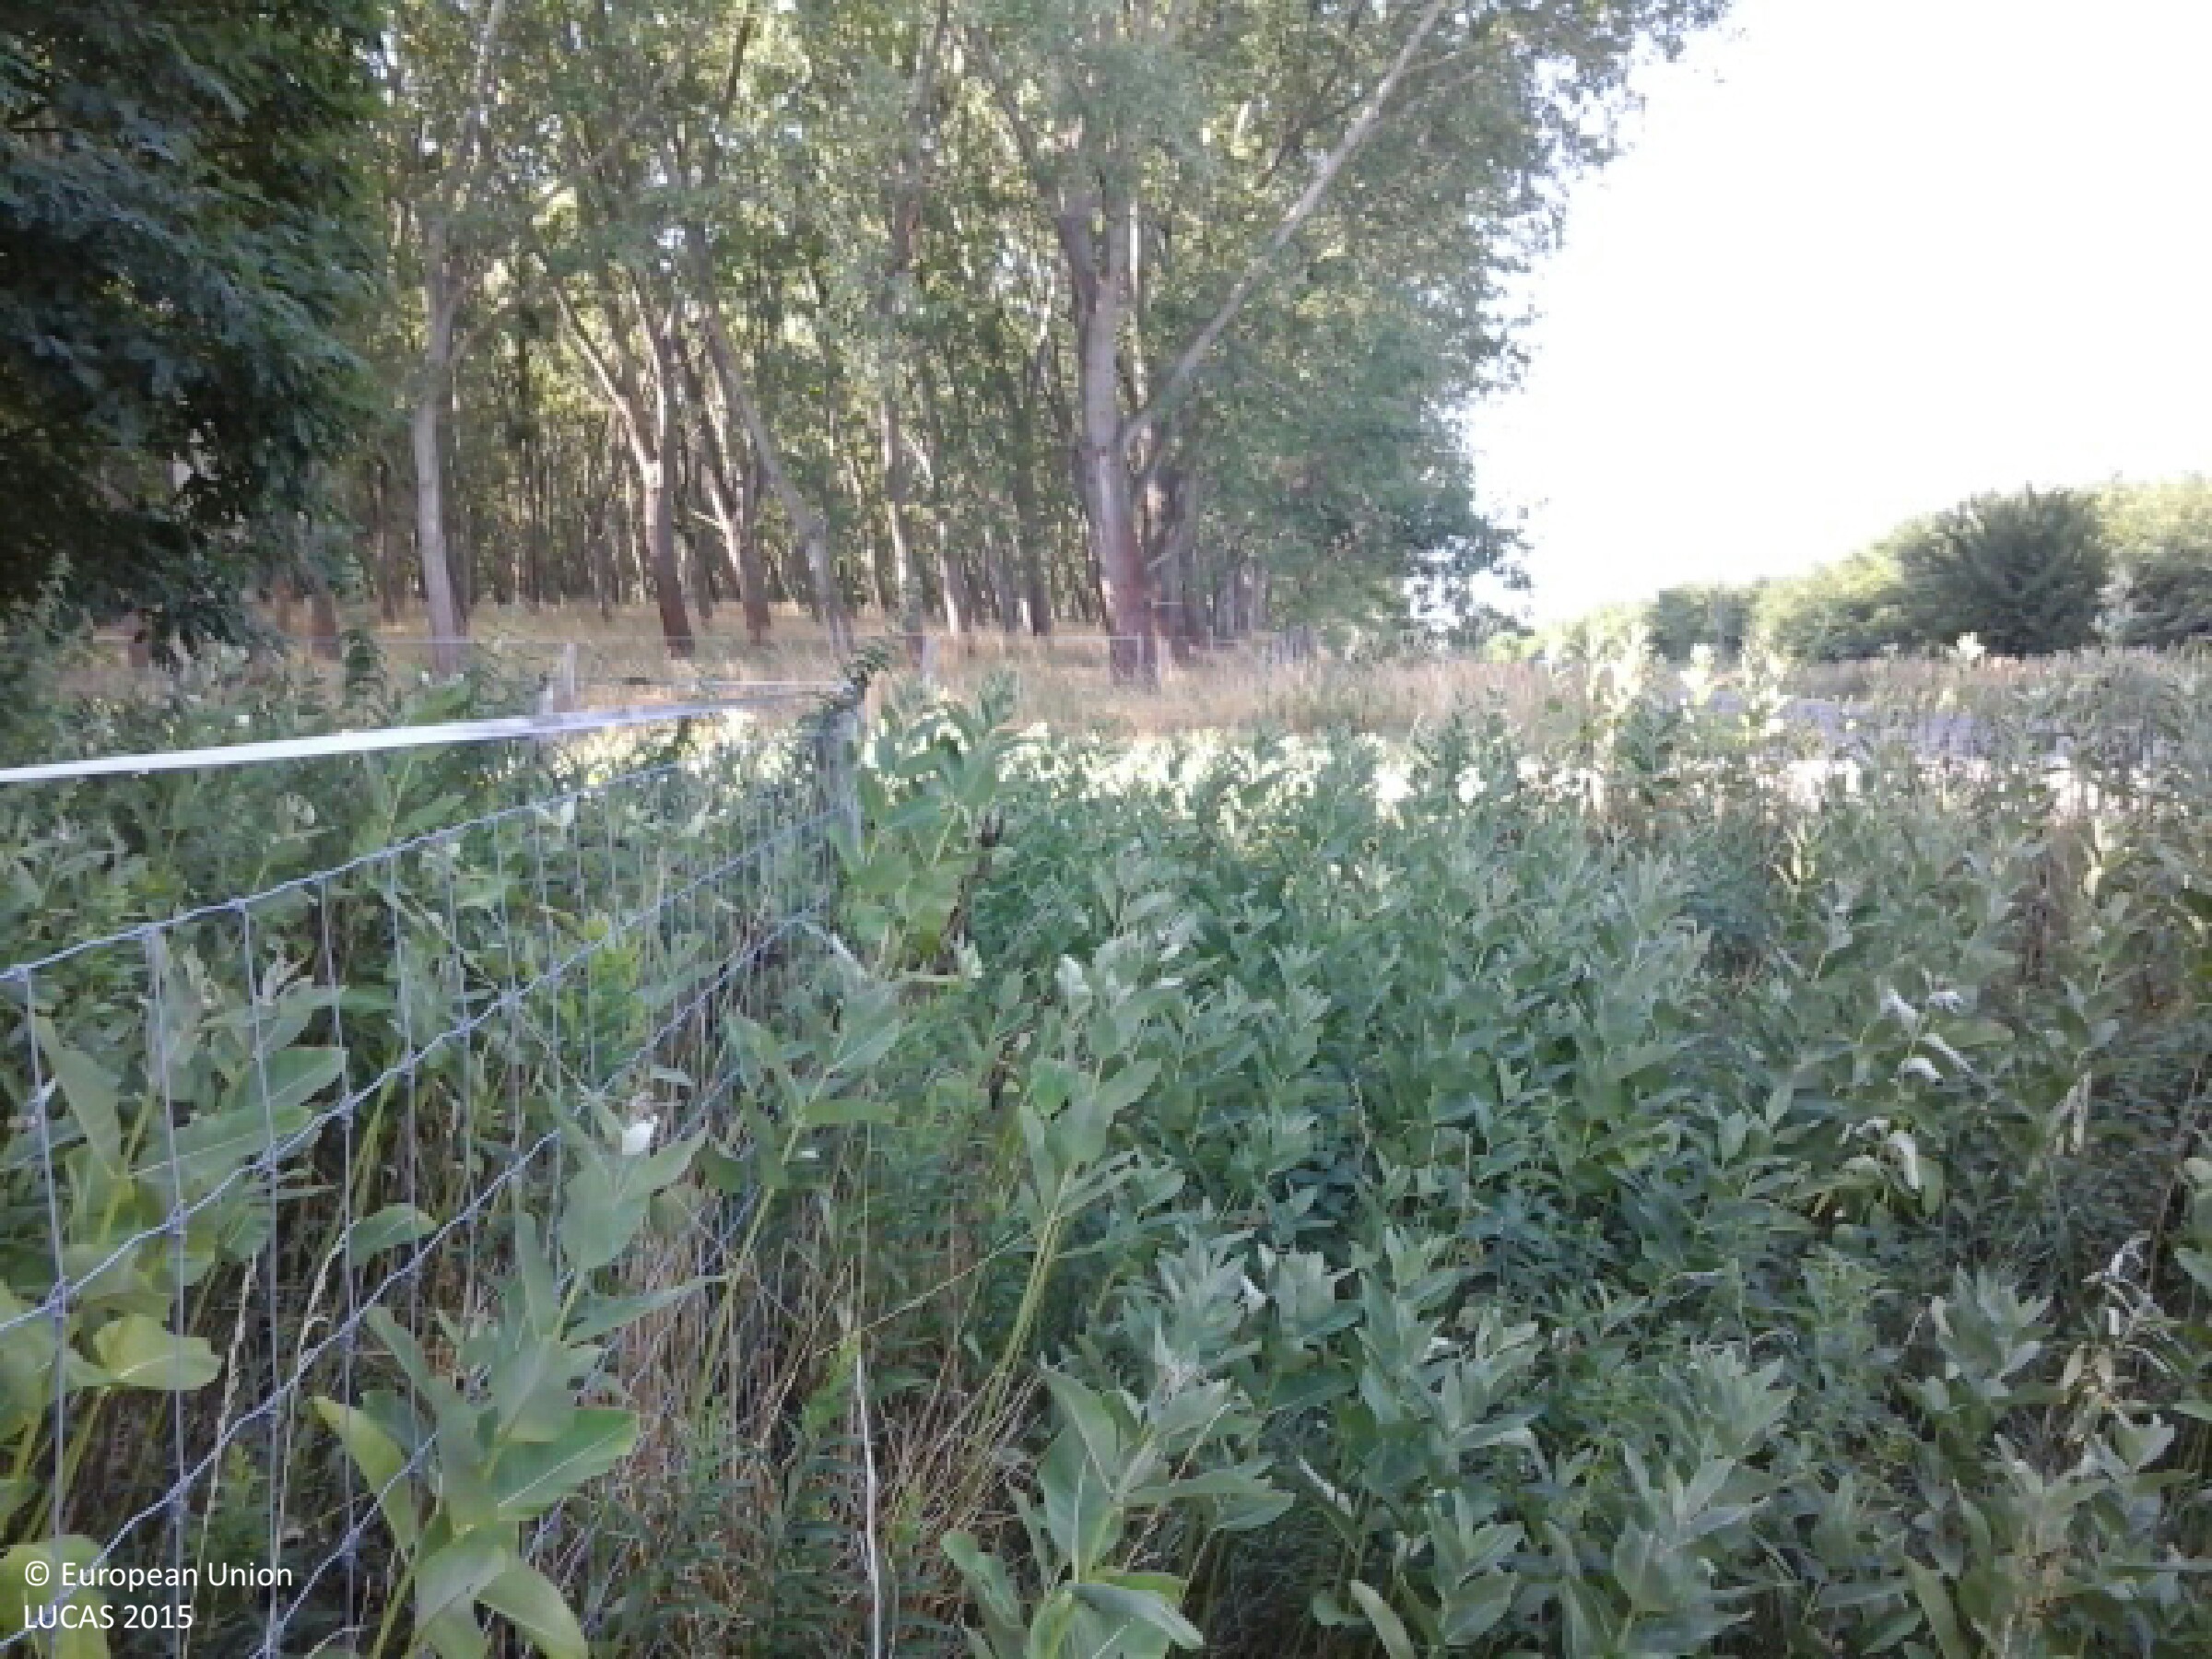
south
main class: Woodland
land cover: Broadleaved woodland
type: exotic forest
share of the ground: > 75 %
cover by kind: broadleaved forest trees 95 %, herbaceous plants 5 %
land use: Forestry
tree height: > 5 m
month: August
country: HU
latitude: 47.5588
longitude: 17.9180
